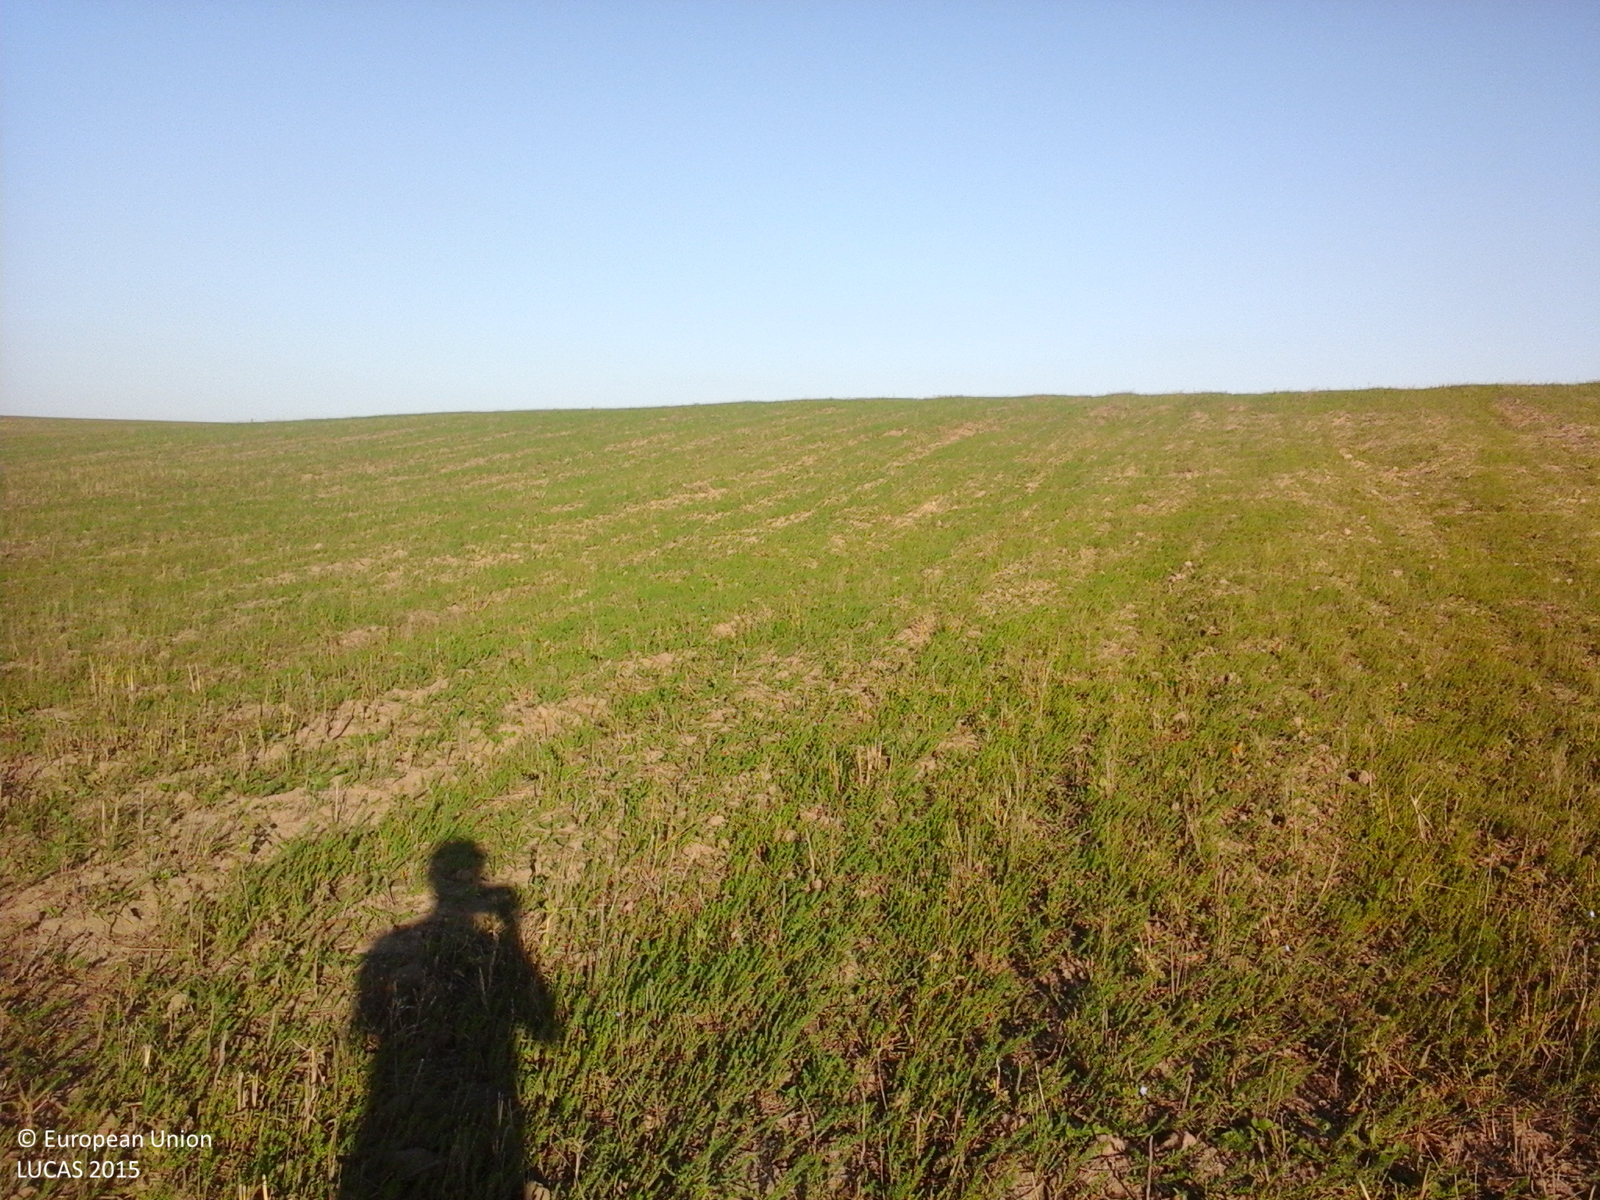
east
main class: Cropland
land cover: Temporary grasslands
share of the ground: > 75 %
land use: Agriculture (excluding fallow land and kitchen gardens)
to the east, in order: Temporary grasslands
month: October
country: RO
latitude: 45.3753
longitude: 27.3746
